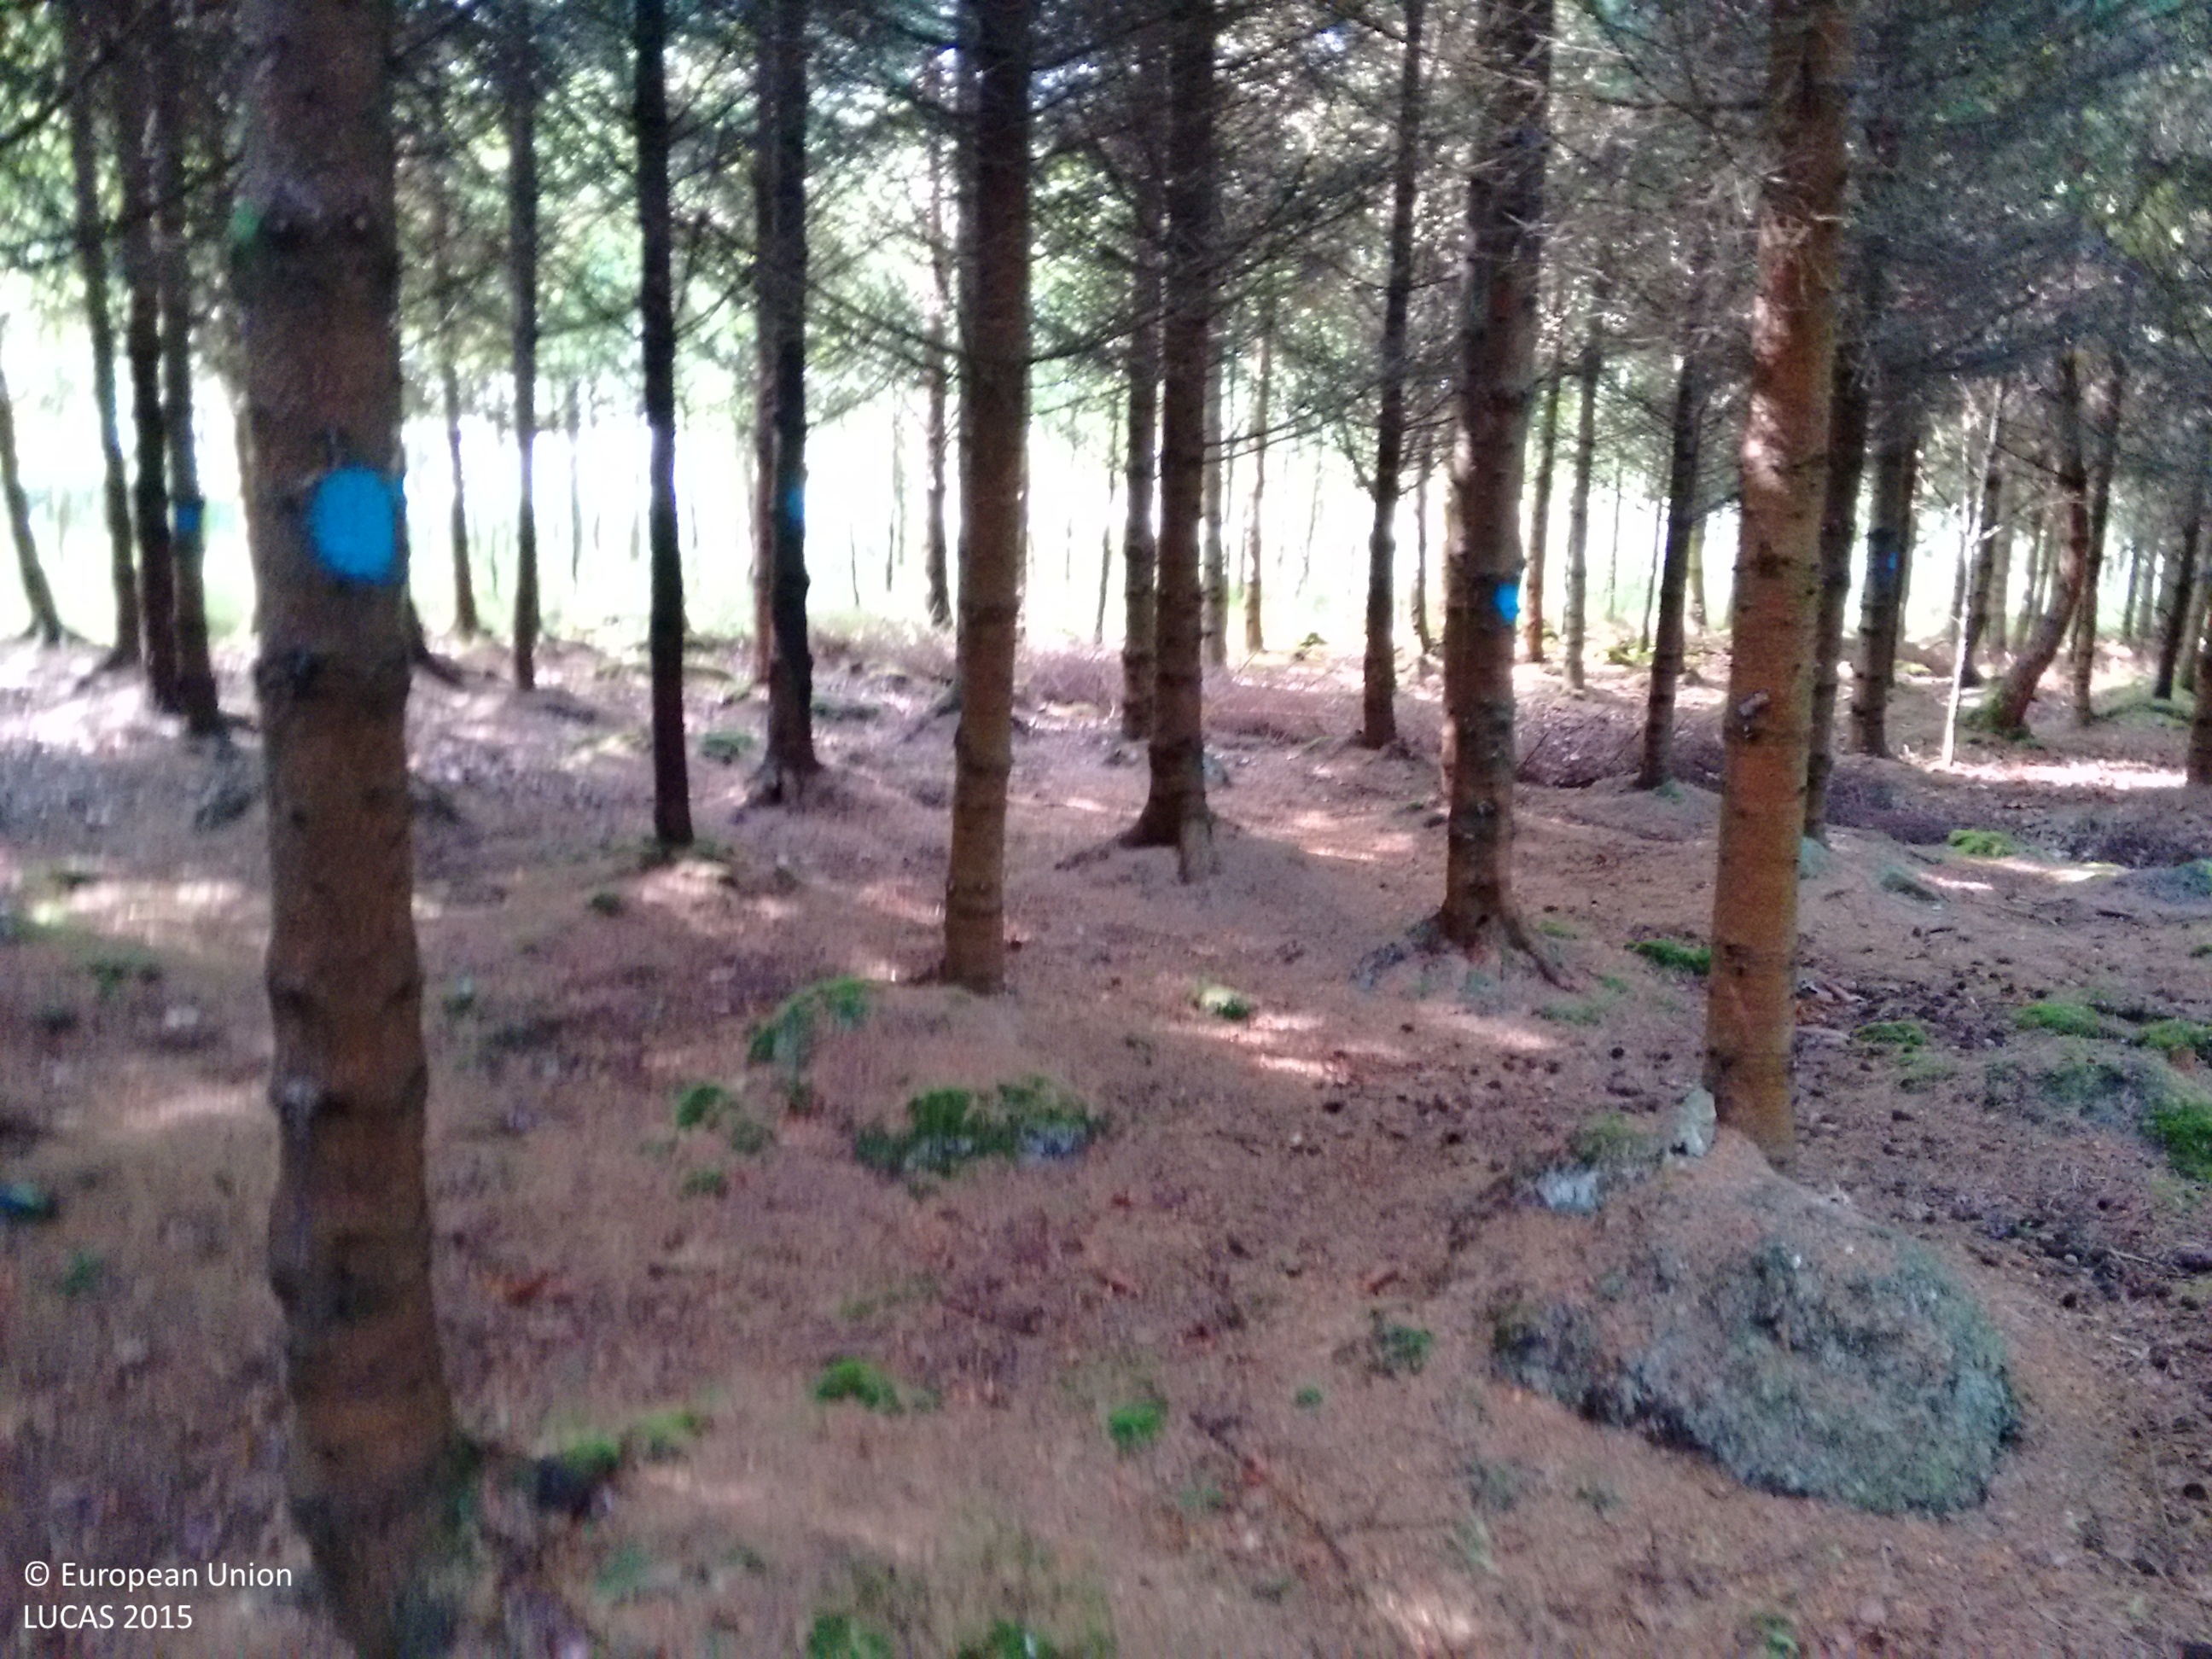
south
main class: Woodland
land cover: Spruce dominated coniferous woodland
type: exotic forest
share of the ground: > 75 %
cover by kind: coniferous forest trees 95 %, lichens and mosses 5 %
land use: Forestry
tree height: > 5 m
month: June
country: IE
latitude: 52.2816
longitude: -7.1058
